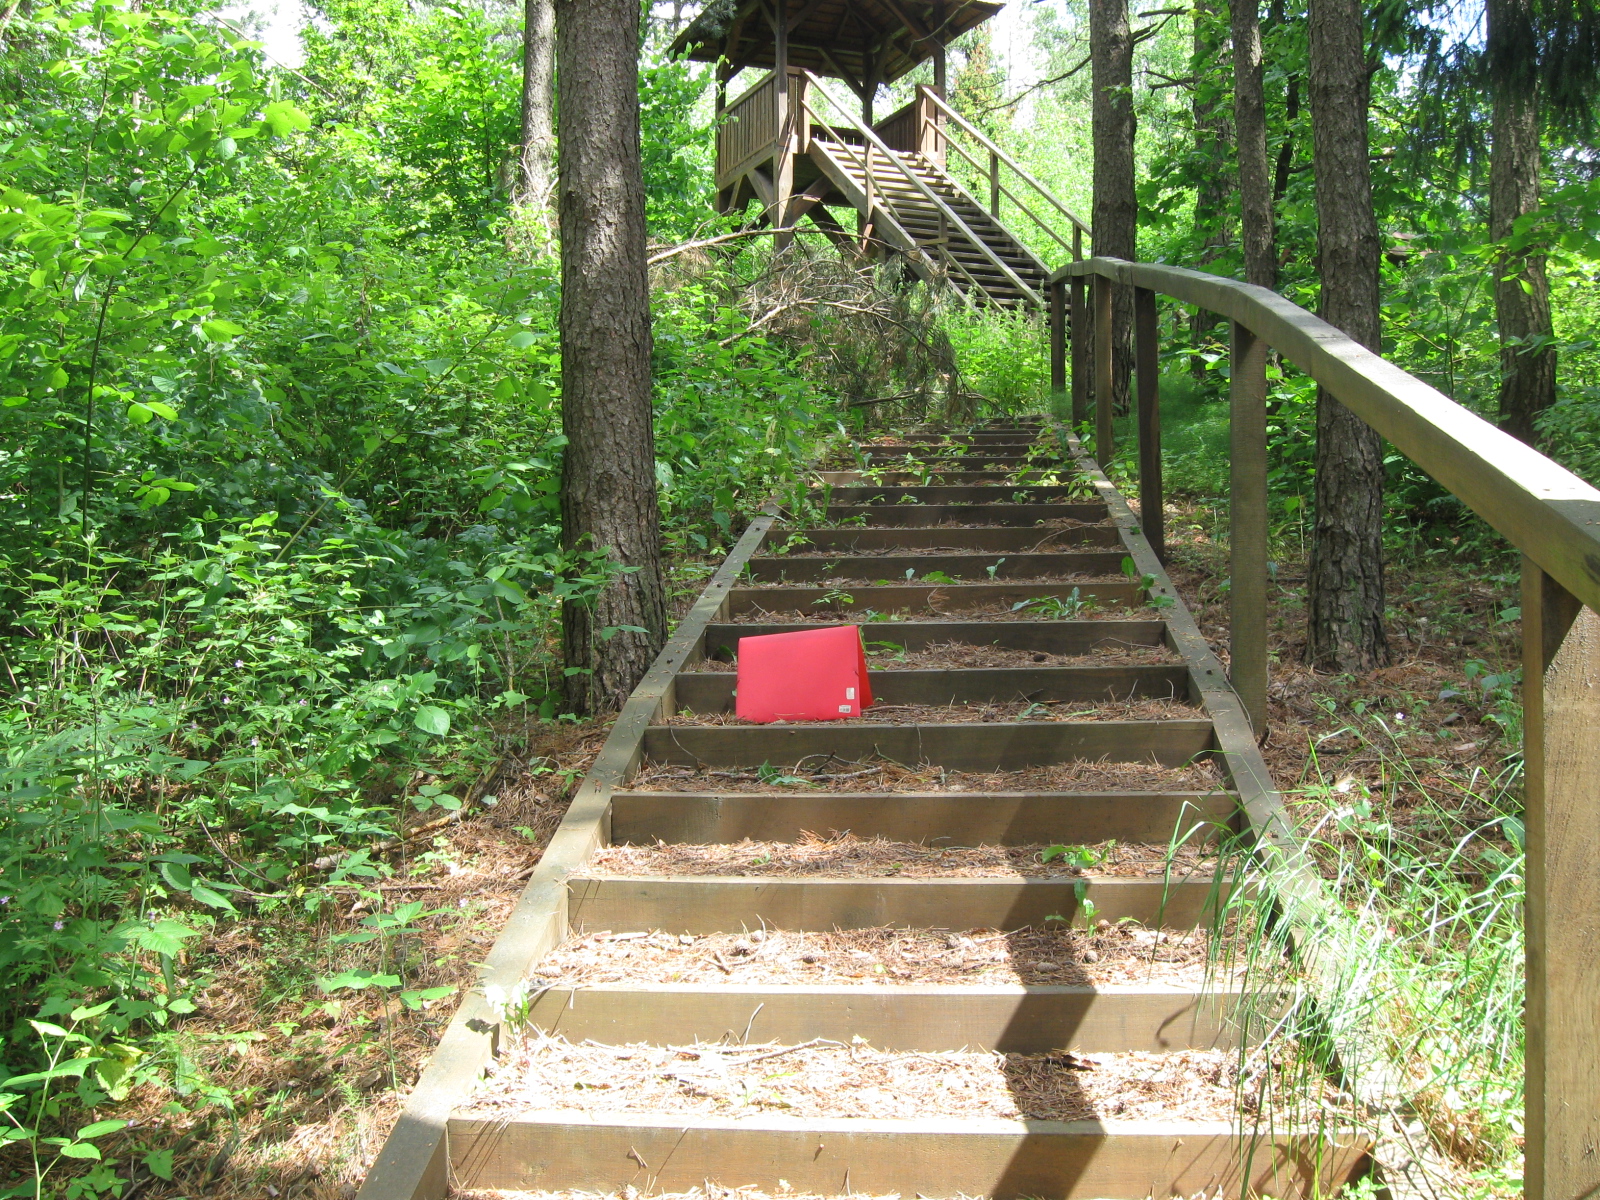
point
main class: Woodland
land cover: Pine dominated mixed woodland
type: hemiboreal forest and nemoral coniferous forest and mixed broadleaved-coniferous forest
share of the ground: > 75 %
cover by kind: coniferous forest trees 65 %, broadleaved forest trees 30 %, herbaceous plants 5 %
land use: Forestry
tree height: > 5 m
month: June
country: LT
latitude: 54.6305
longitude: 24.4618
